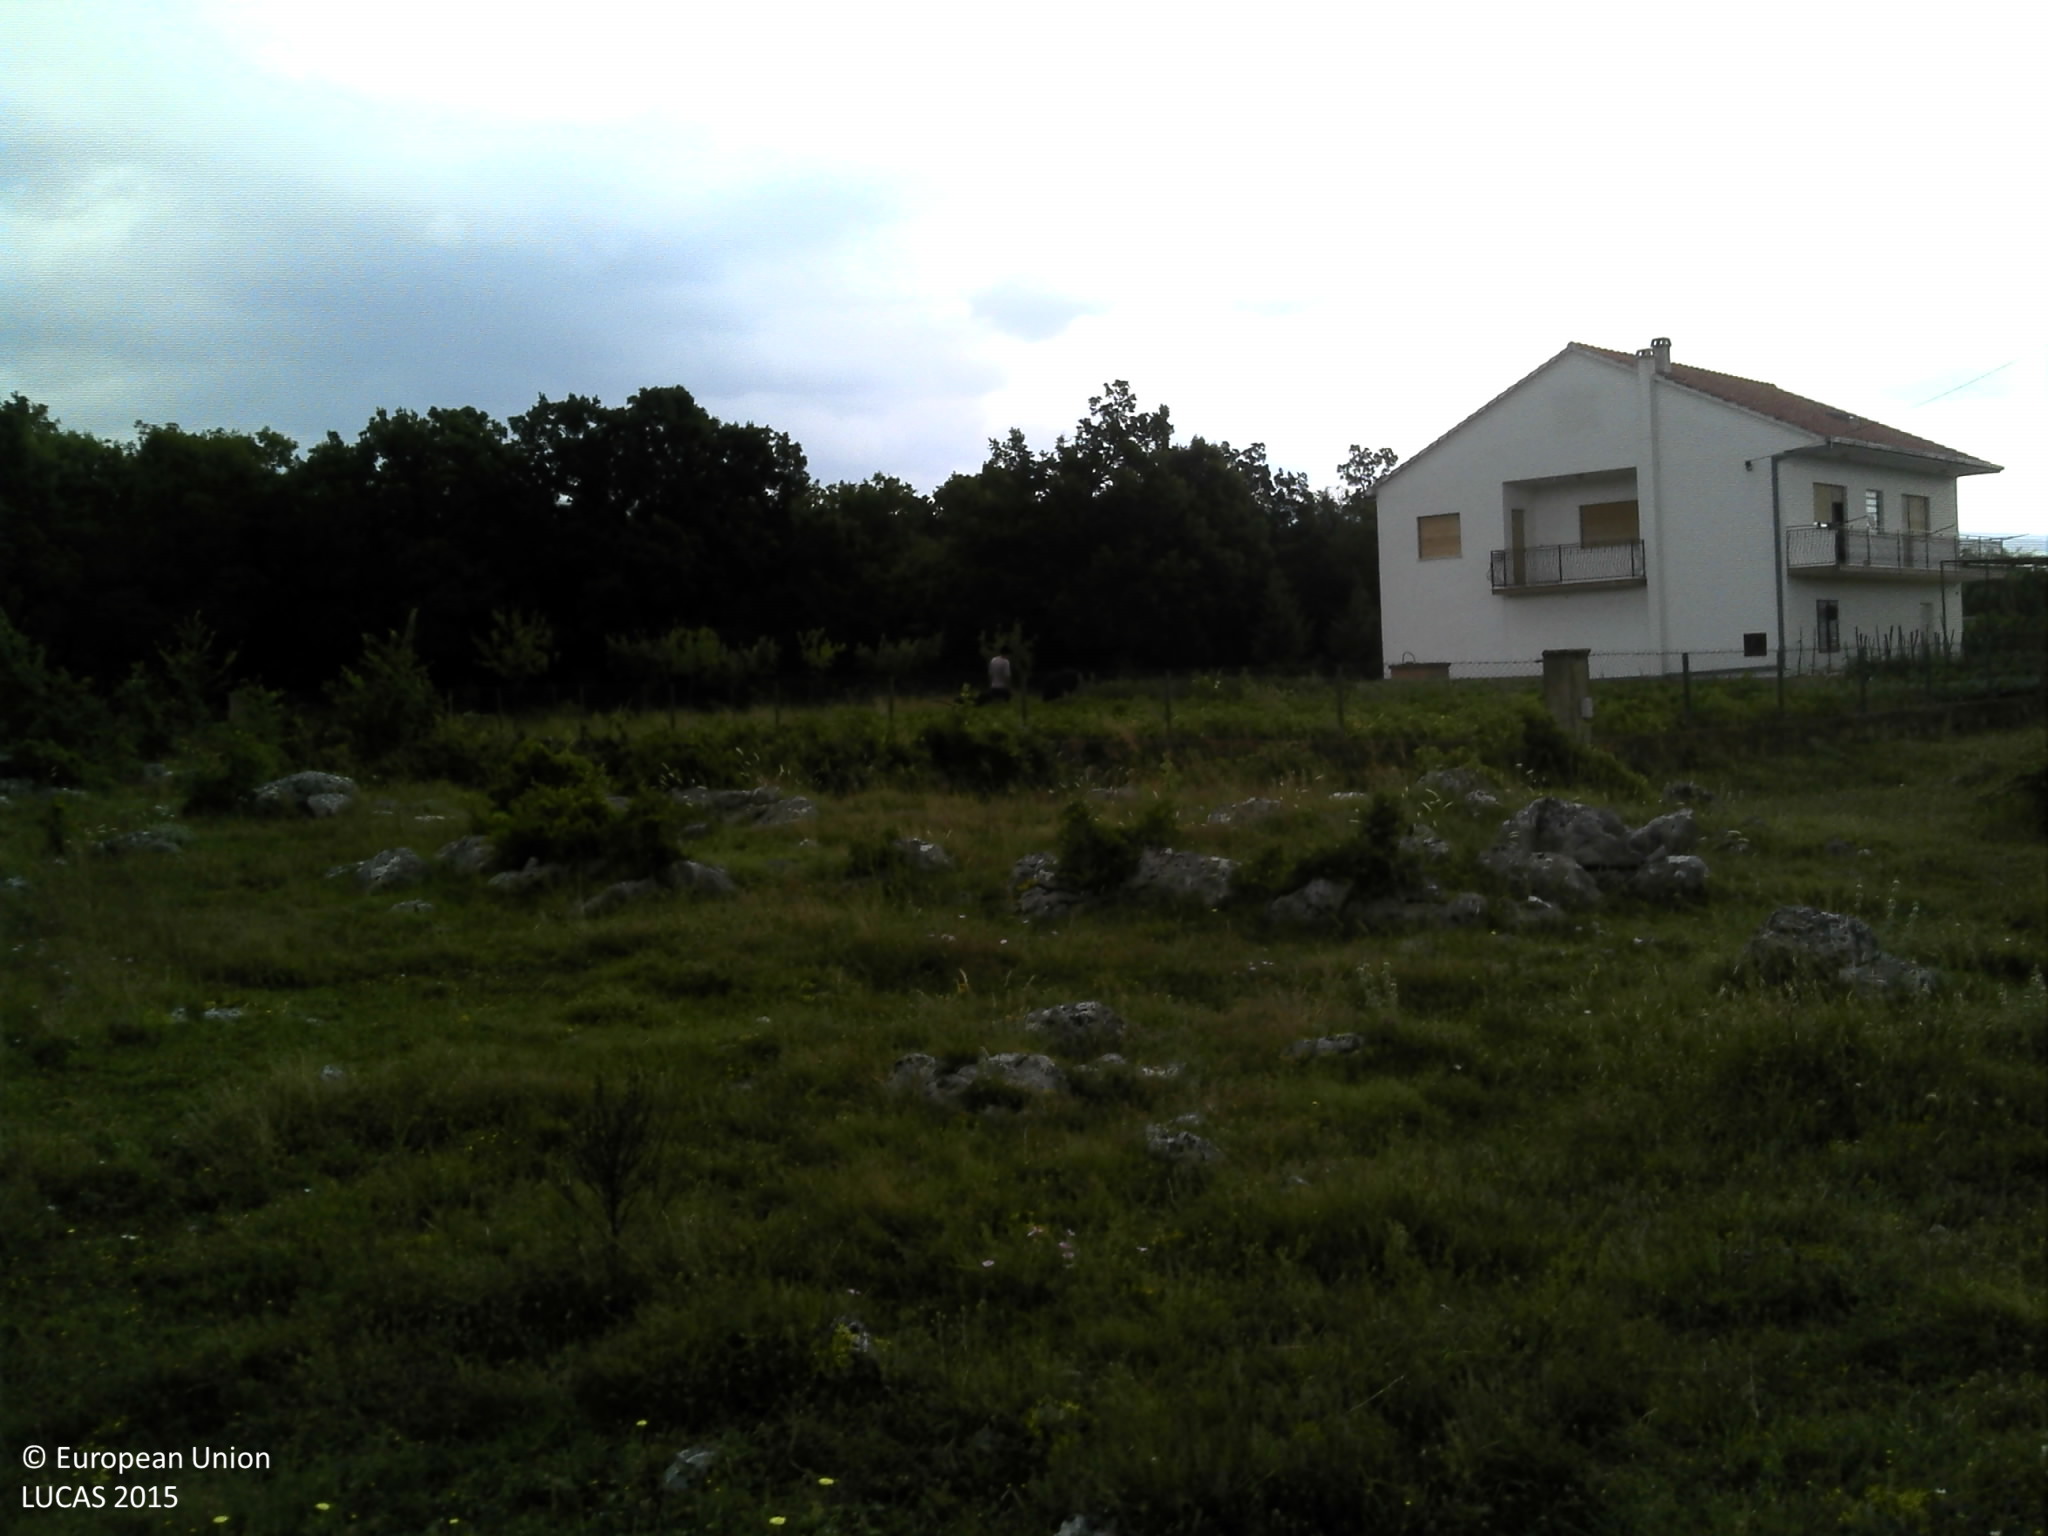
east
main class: Grassland
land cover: Grassland with sparse tree/shrub cover
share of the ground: 50 - 75 %
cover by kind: herbaceous plants 65 %, unconsolidated bare surface 20 %, broadleaved forest trees 5 %, shrubs 5 %, consolidated bare surface 5 %
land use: Abandoned areas
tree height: > 5 m
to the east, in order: Grassland with sparse tree/shrub cover; Fences; Potatoes; Artificial constructions in urban areas; Fences; Tracks; Dry stone walls; Grassland with sparse tree/shrub cover; Dry stone walls; Grassland with sparse tree/shrub cover; Shrubland with sparse tree cover; Tracks; Fences; Vineyards; Fences; Tracks; Dry stone walls; Other fresh vegetables; Dry stone walls; Shrubland with sparse tree cover; Tracks; Shrubland with sparse tree cover; Dry stone walls; Broadleaved woodland
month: June
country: HR
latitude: 43.7955
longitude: 16.6165
